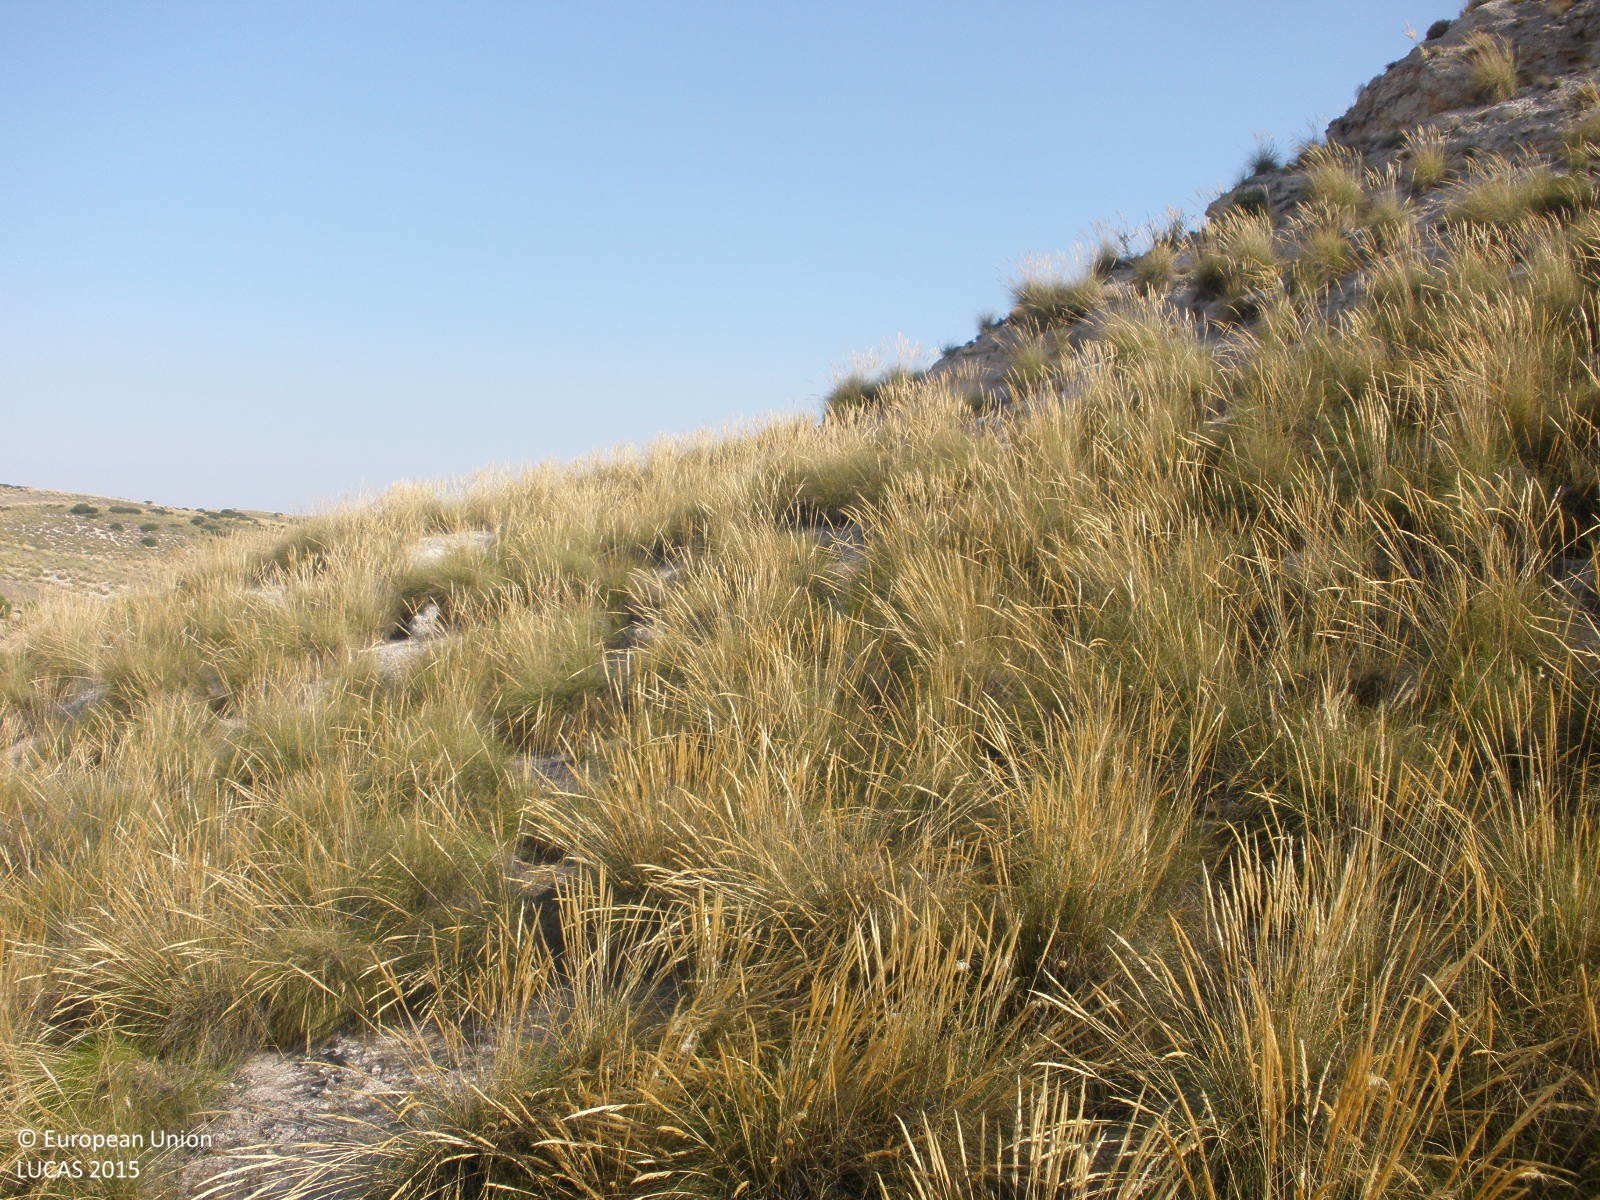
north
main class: Shrubland
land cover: Shrubland without tree cover
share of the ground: 50 - 75 %
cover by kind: shrubs 60 %, herbaceous plants 20 %, consolidated bare surface 20 %
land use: Semi-natural and natural areas not in use
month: July
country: ES
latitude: 39.9661
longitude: -3.2674
